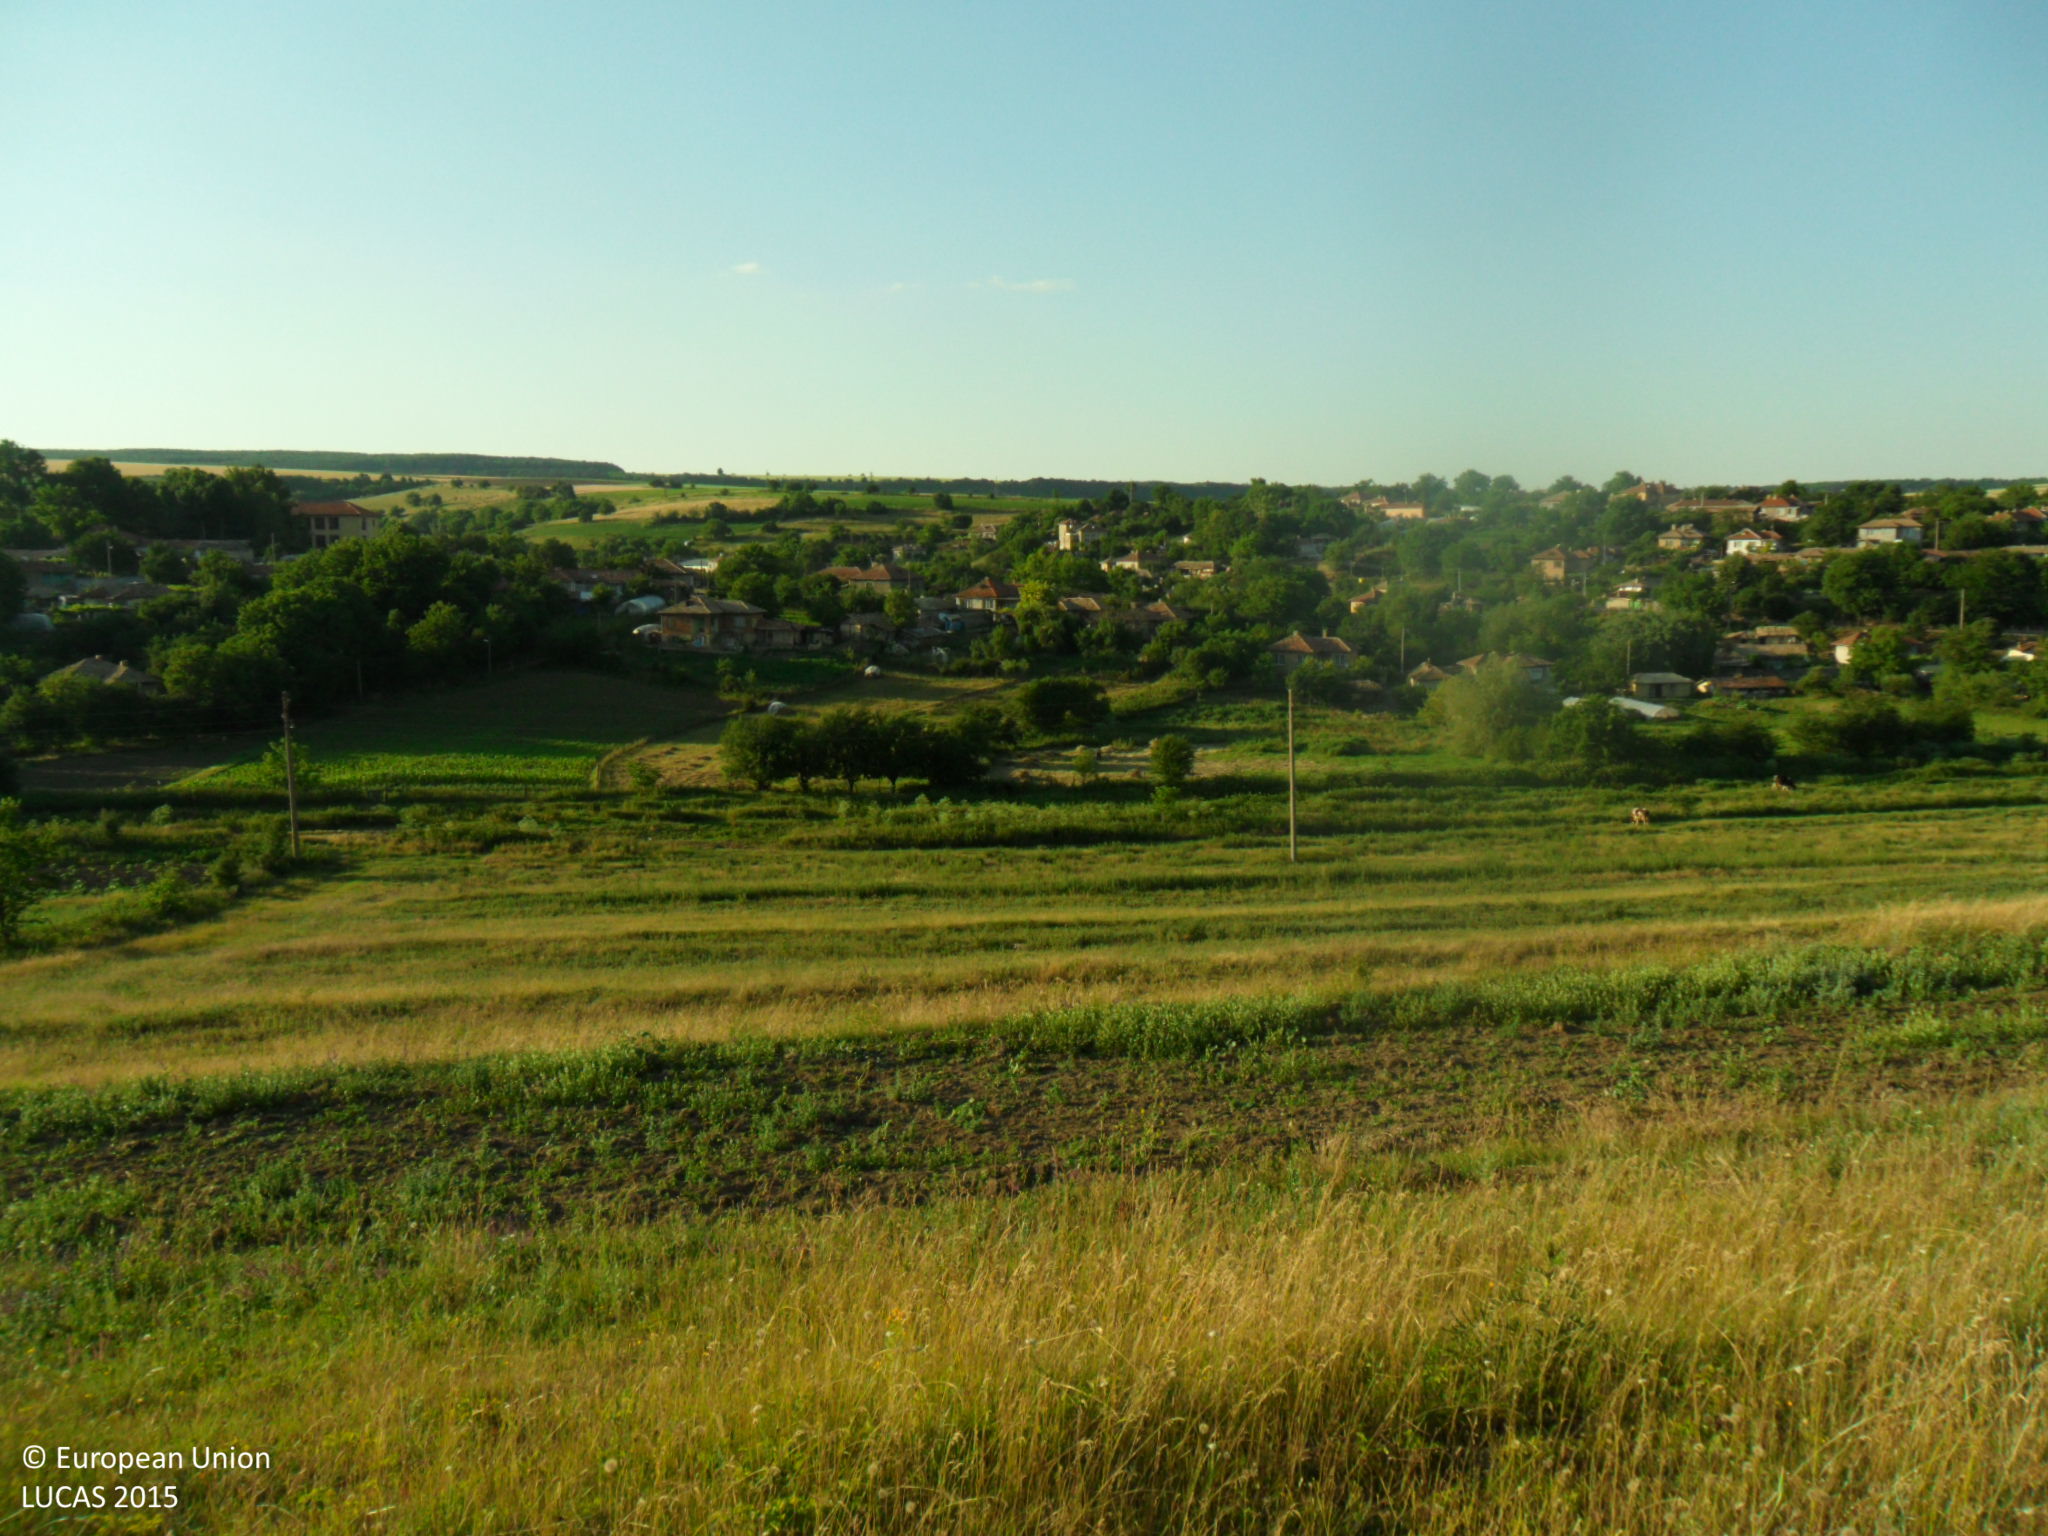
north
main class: Grassland
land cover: Grassland with sparse tree/shrub cover
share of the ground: > 75 %
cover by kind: herbaceous plants 90 %, broadleaved forest trees 5 %, shrubs 5 %
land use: Agriculture (excluding fallow land and kitchen gardens)
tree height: < 5 m
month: June
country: BG
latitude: 43.4773
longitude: 26.8399
